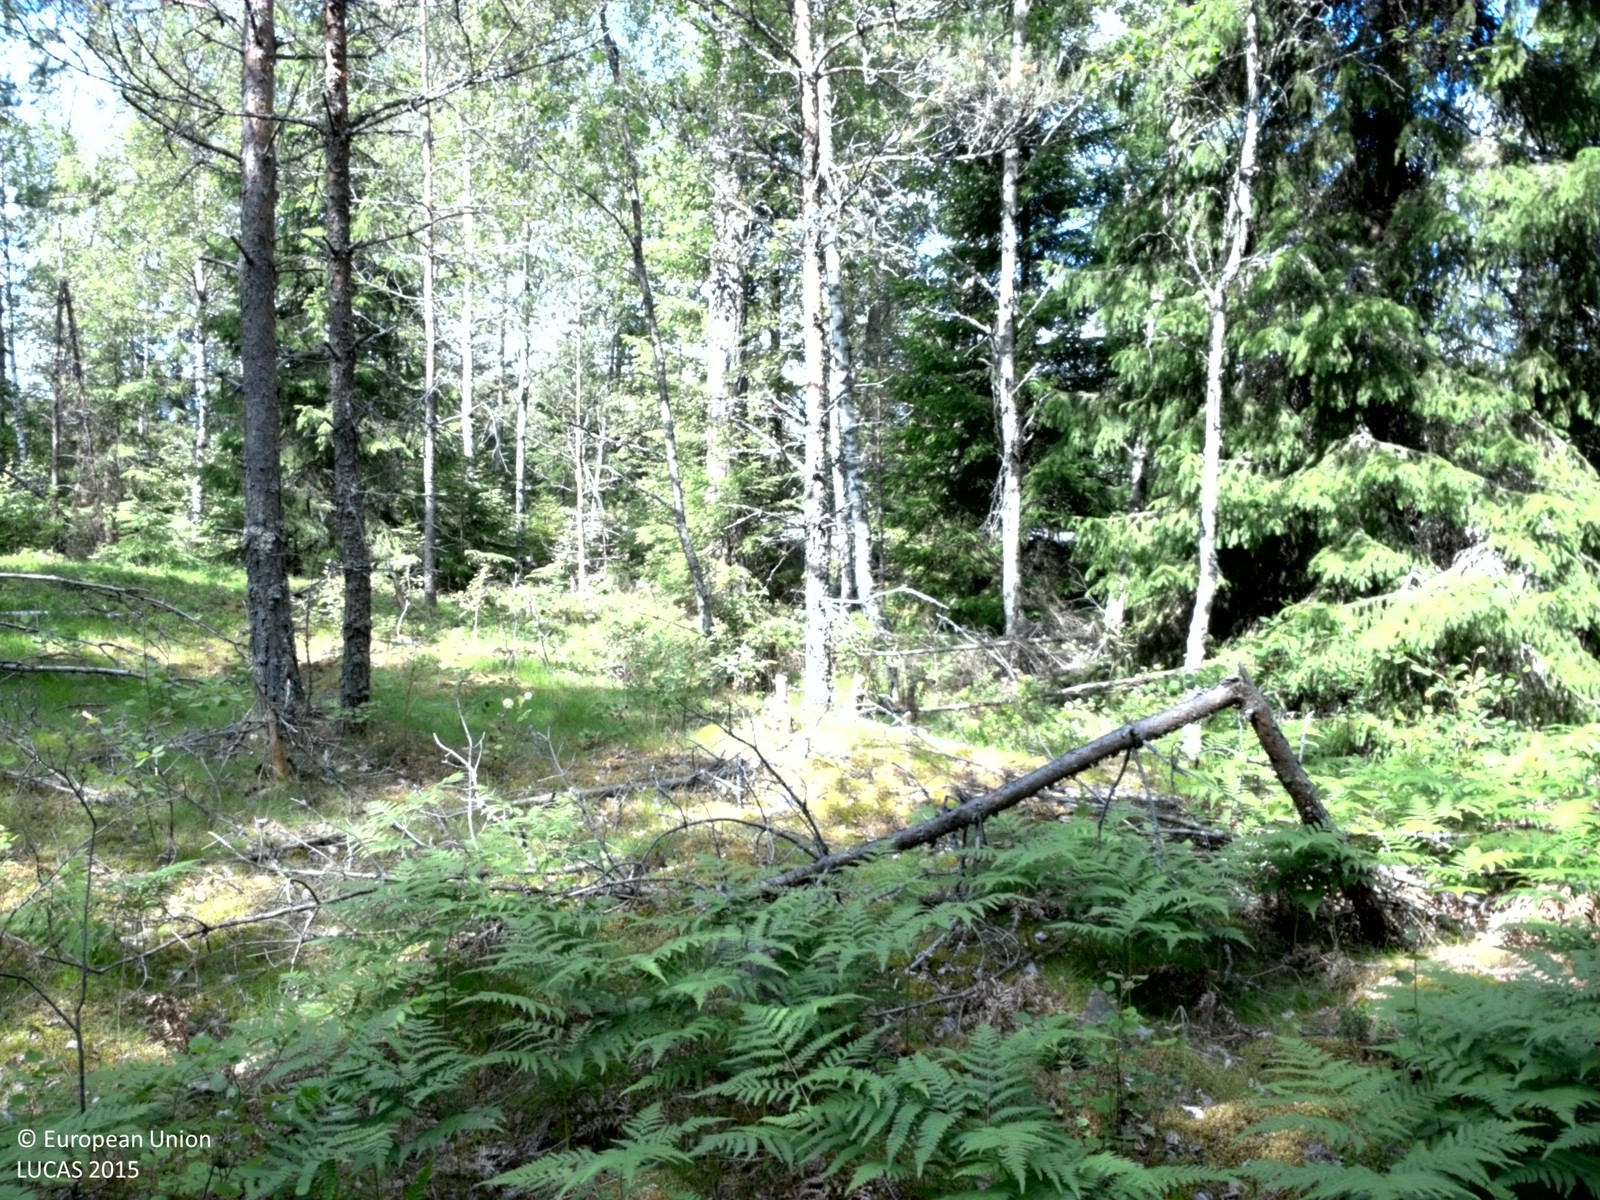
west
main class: Woodland
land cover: Spruce dominated mixed woodland
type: boreal forest
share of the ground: 50 - 75 %
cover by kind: coniferous forest trees 45 %, herbaceous plants 20 %, lichens and mosses 20 %, broadleaved forest trees 15 %
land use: Forestry
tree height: > 5 m
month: June
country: SE
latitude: 59.6272
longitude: 18.3144
